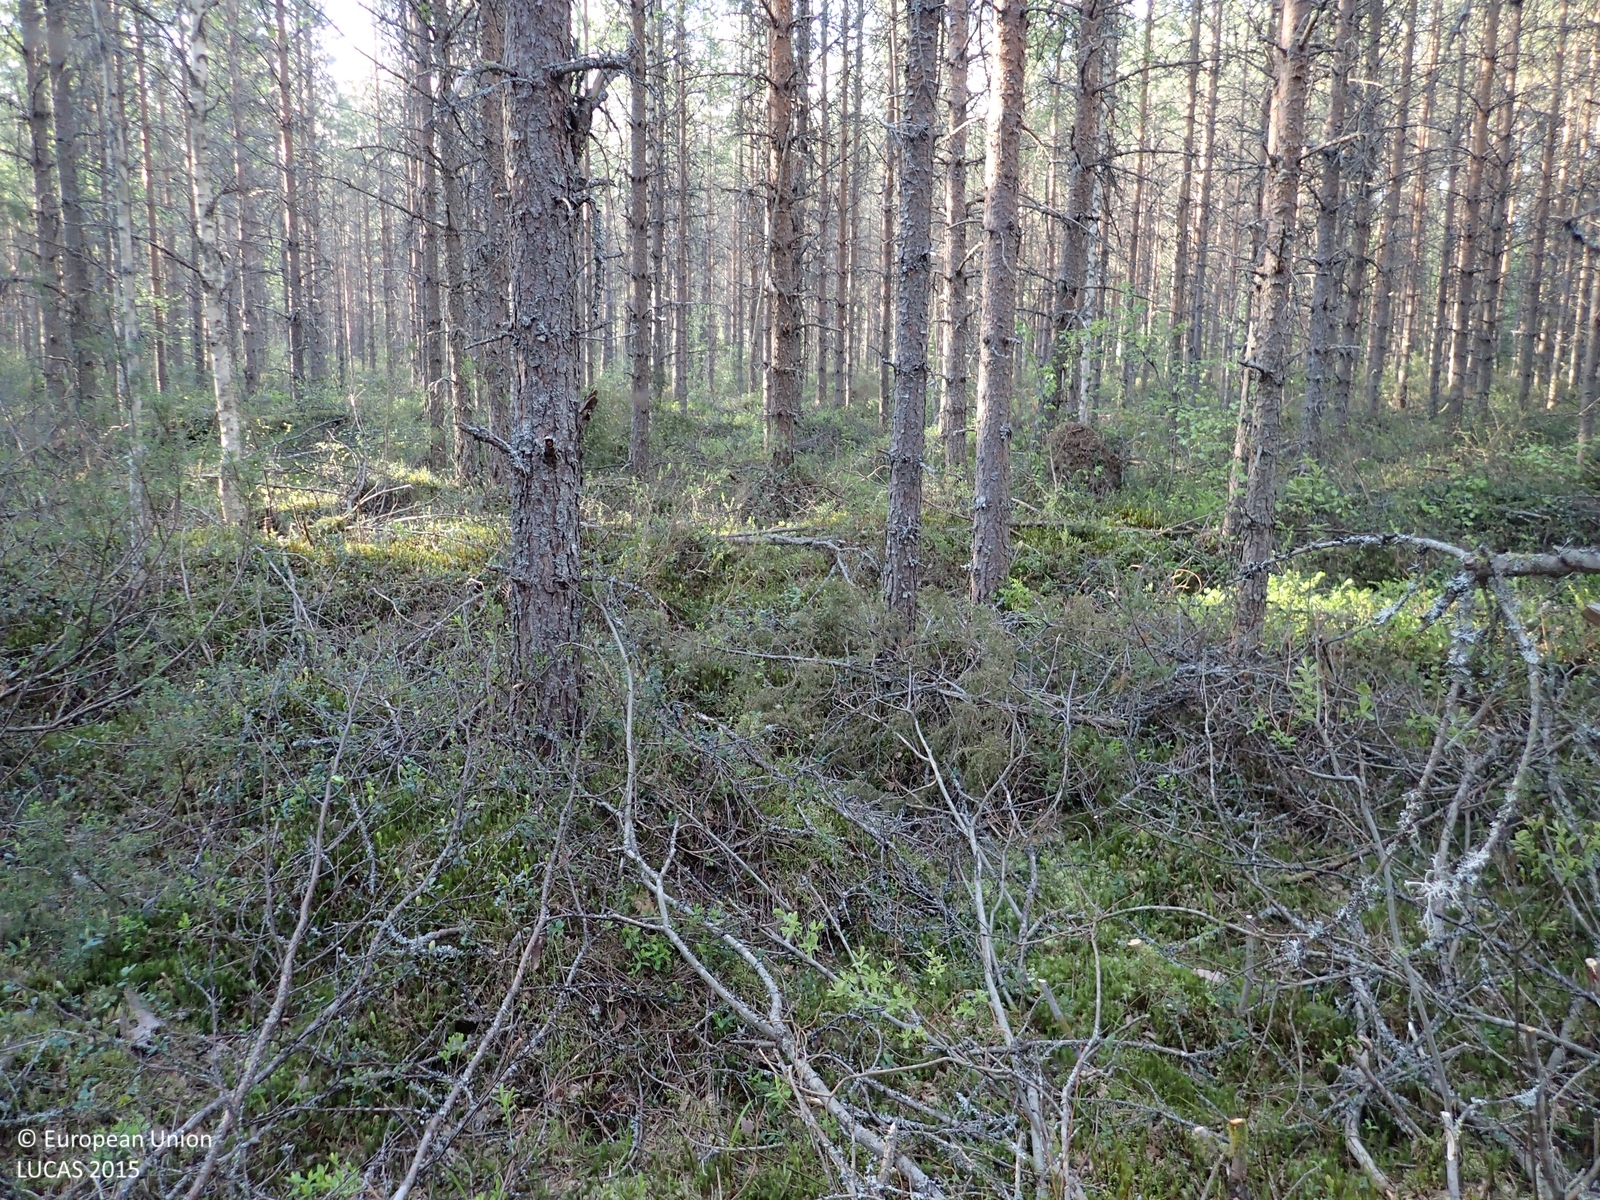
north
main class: Woodland
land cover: Pine dominated mixed woodland
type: boreal forest
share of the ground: > 75 %
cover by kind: coniferous forest trees 55 %, broadleaved forest trees 25 %, shrubs 20 %
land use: Forestry
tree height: > 5 m
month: June
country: FI
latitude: 62.1818
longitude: 22.4858
